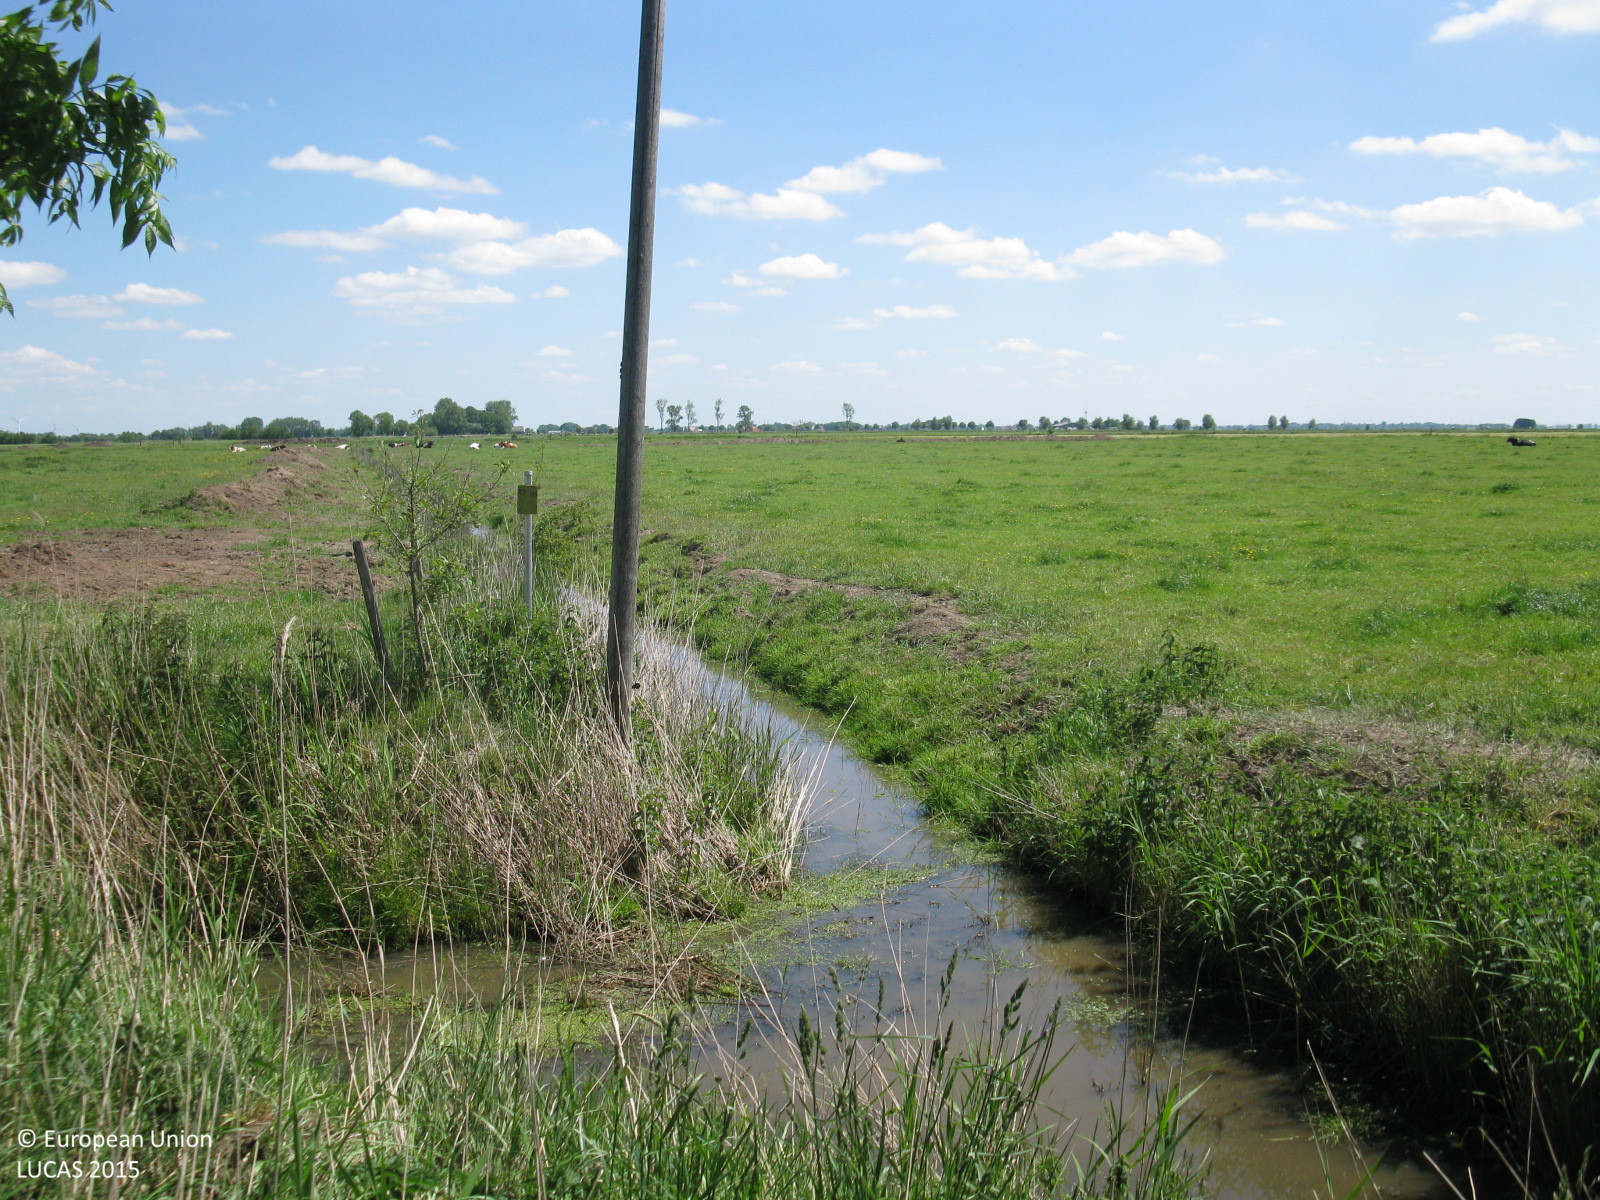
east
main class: Grassland
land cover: Grassland without tree/shrub cover
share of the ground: > 75 %
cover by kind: herbaceous plants 100 %
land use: Agriculture (excluding fallow land and kitchen gardens)
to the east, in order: Grassland without tree/shrub cover; Ditches and canals; Grassland without tree/shrub cover
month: June
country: DE
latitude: 53.2996
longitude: 7.2847
